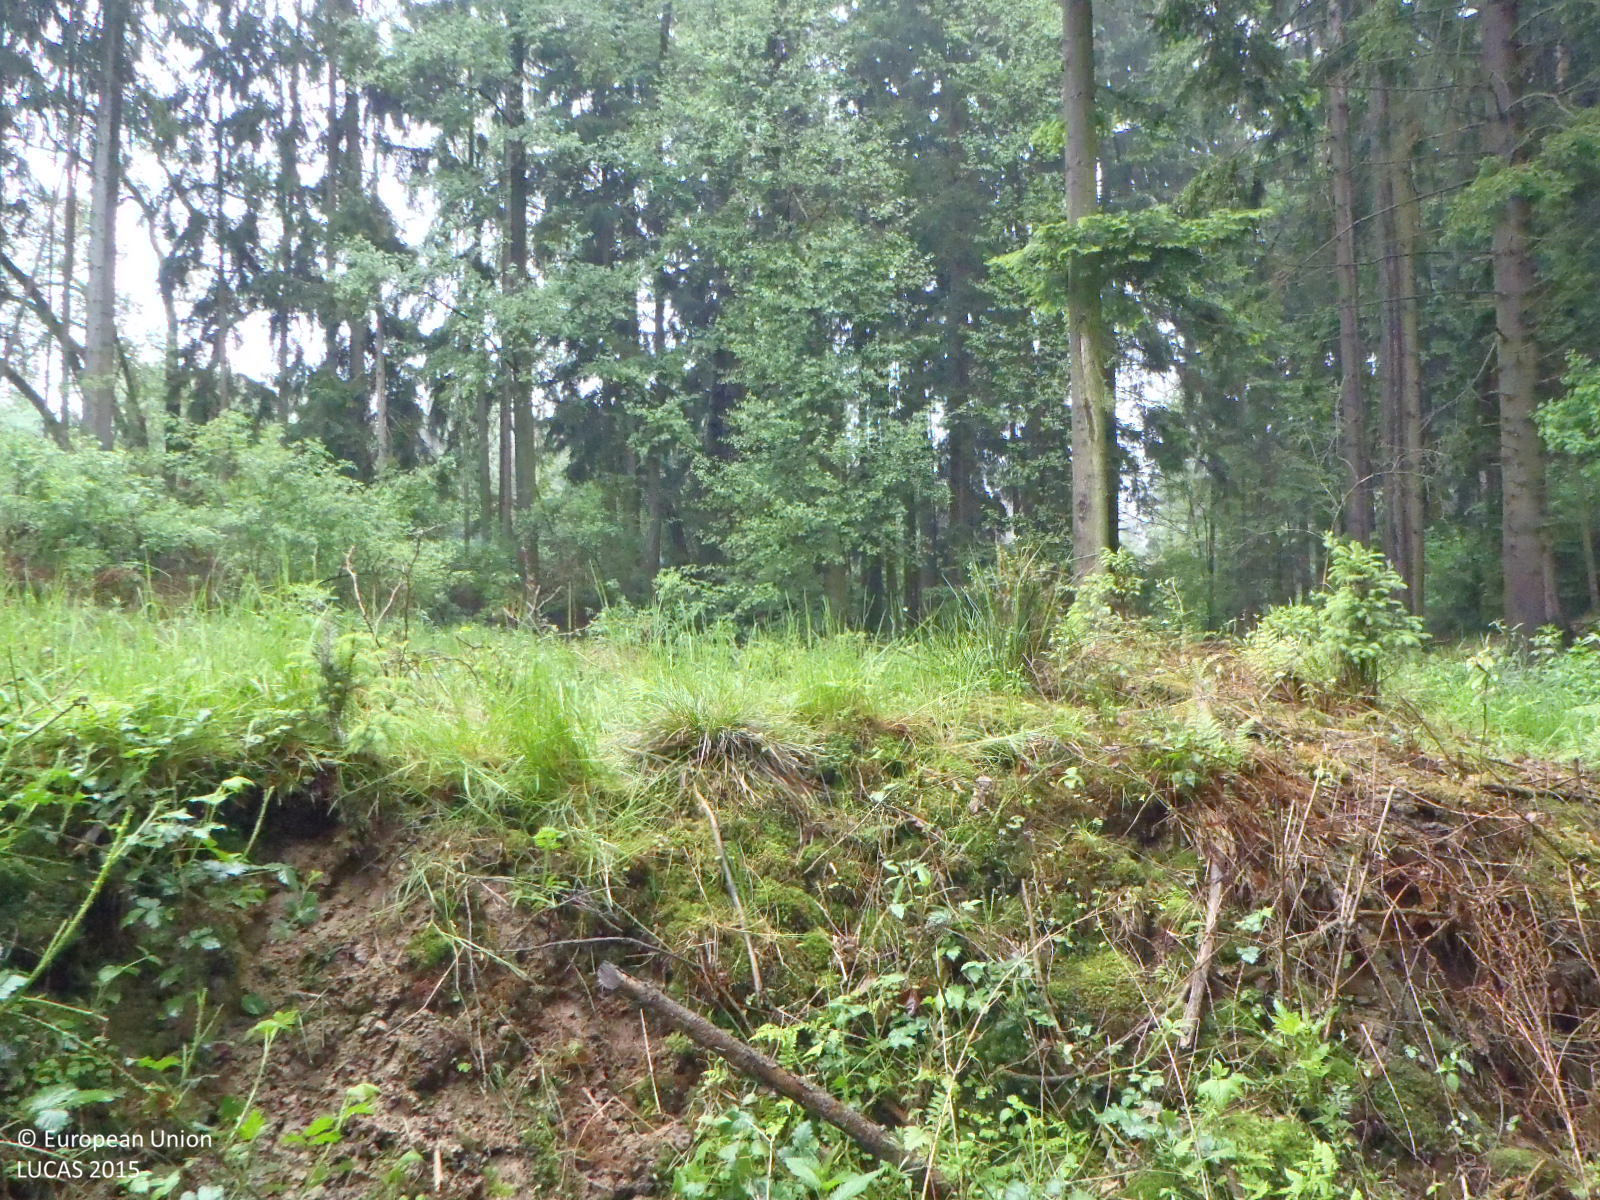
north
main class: Woodland
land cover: Spruce dominated mixed woodland
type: hemiboreal forest and nemoral coniferous forest and mixed broadleaved-coniferous forest
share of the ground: 10 - 25 %
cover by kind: herbaceous plants 50 %, shrubs 20 %, coniferous forest trees 10 %, broadleaved forest trees 10 %, lichens and mosses 5 %, unconsolidated bare surface 5 %
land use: Forestry
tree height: < 5 m
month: May
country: CZ
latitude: 48.8330
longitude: 14.5376
